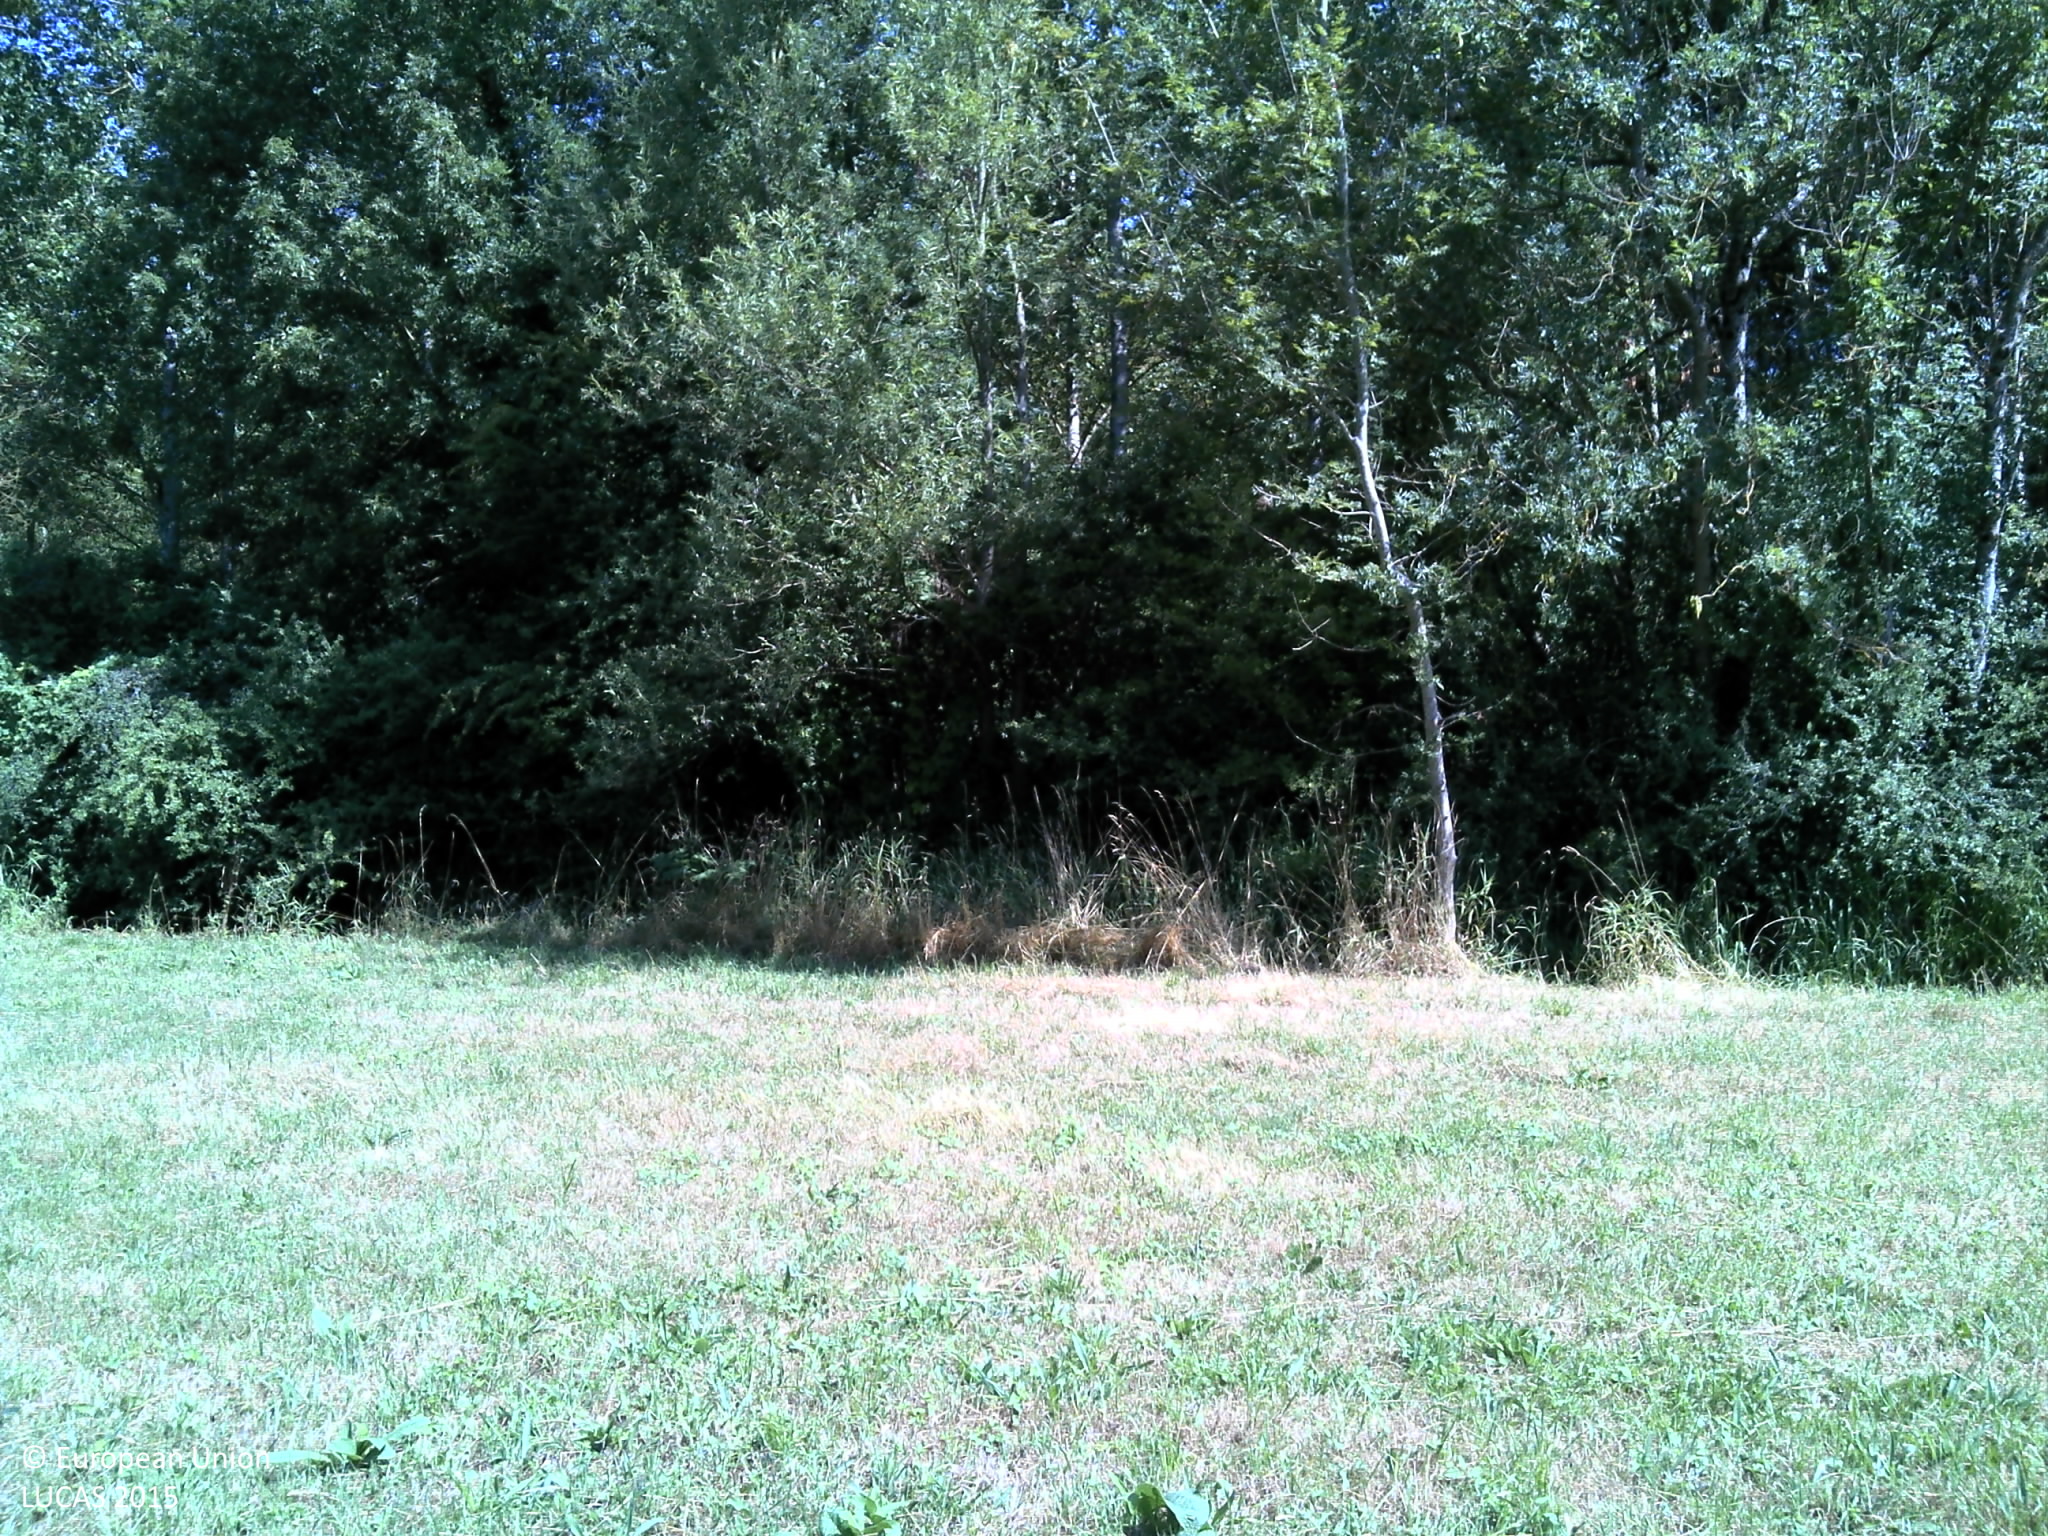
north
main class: Grassland
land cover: Grassland without tree/shrub cover
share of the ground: > 75 %
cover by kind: herbaceous plants 100 %
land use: Agriculture (excluding fallow land and kitchen gardens)
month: July
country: FR
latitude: 48.6738
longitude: 4.7148
